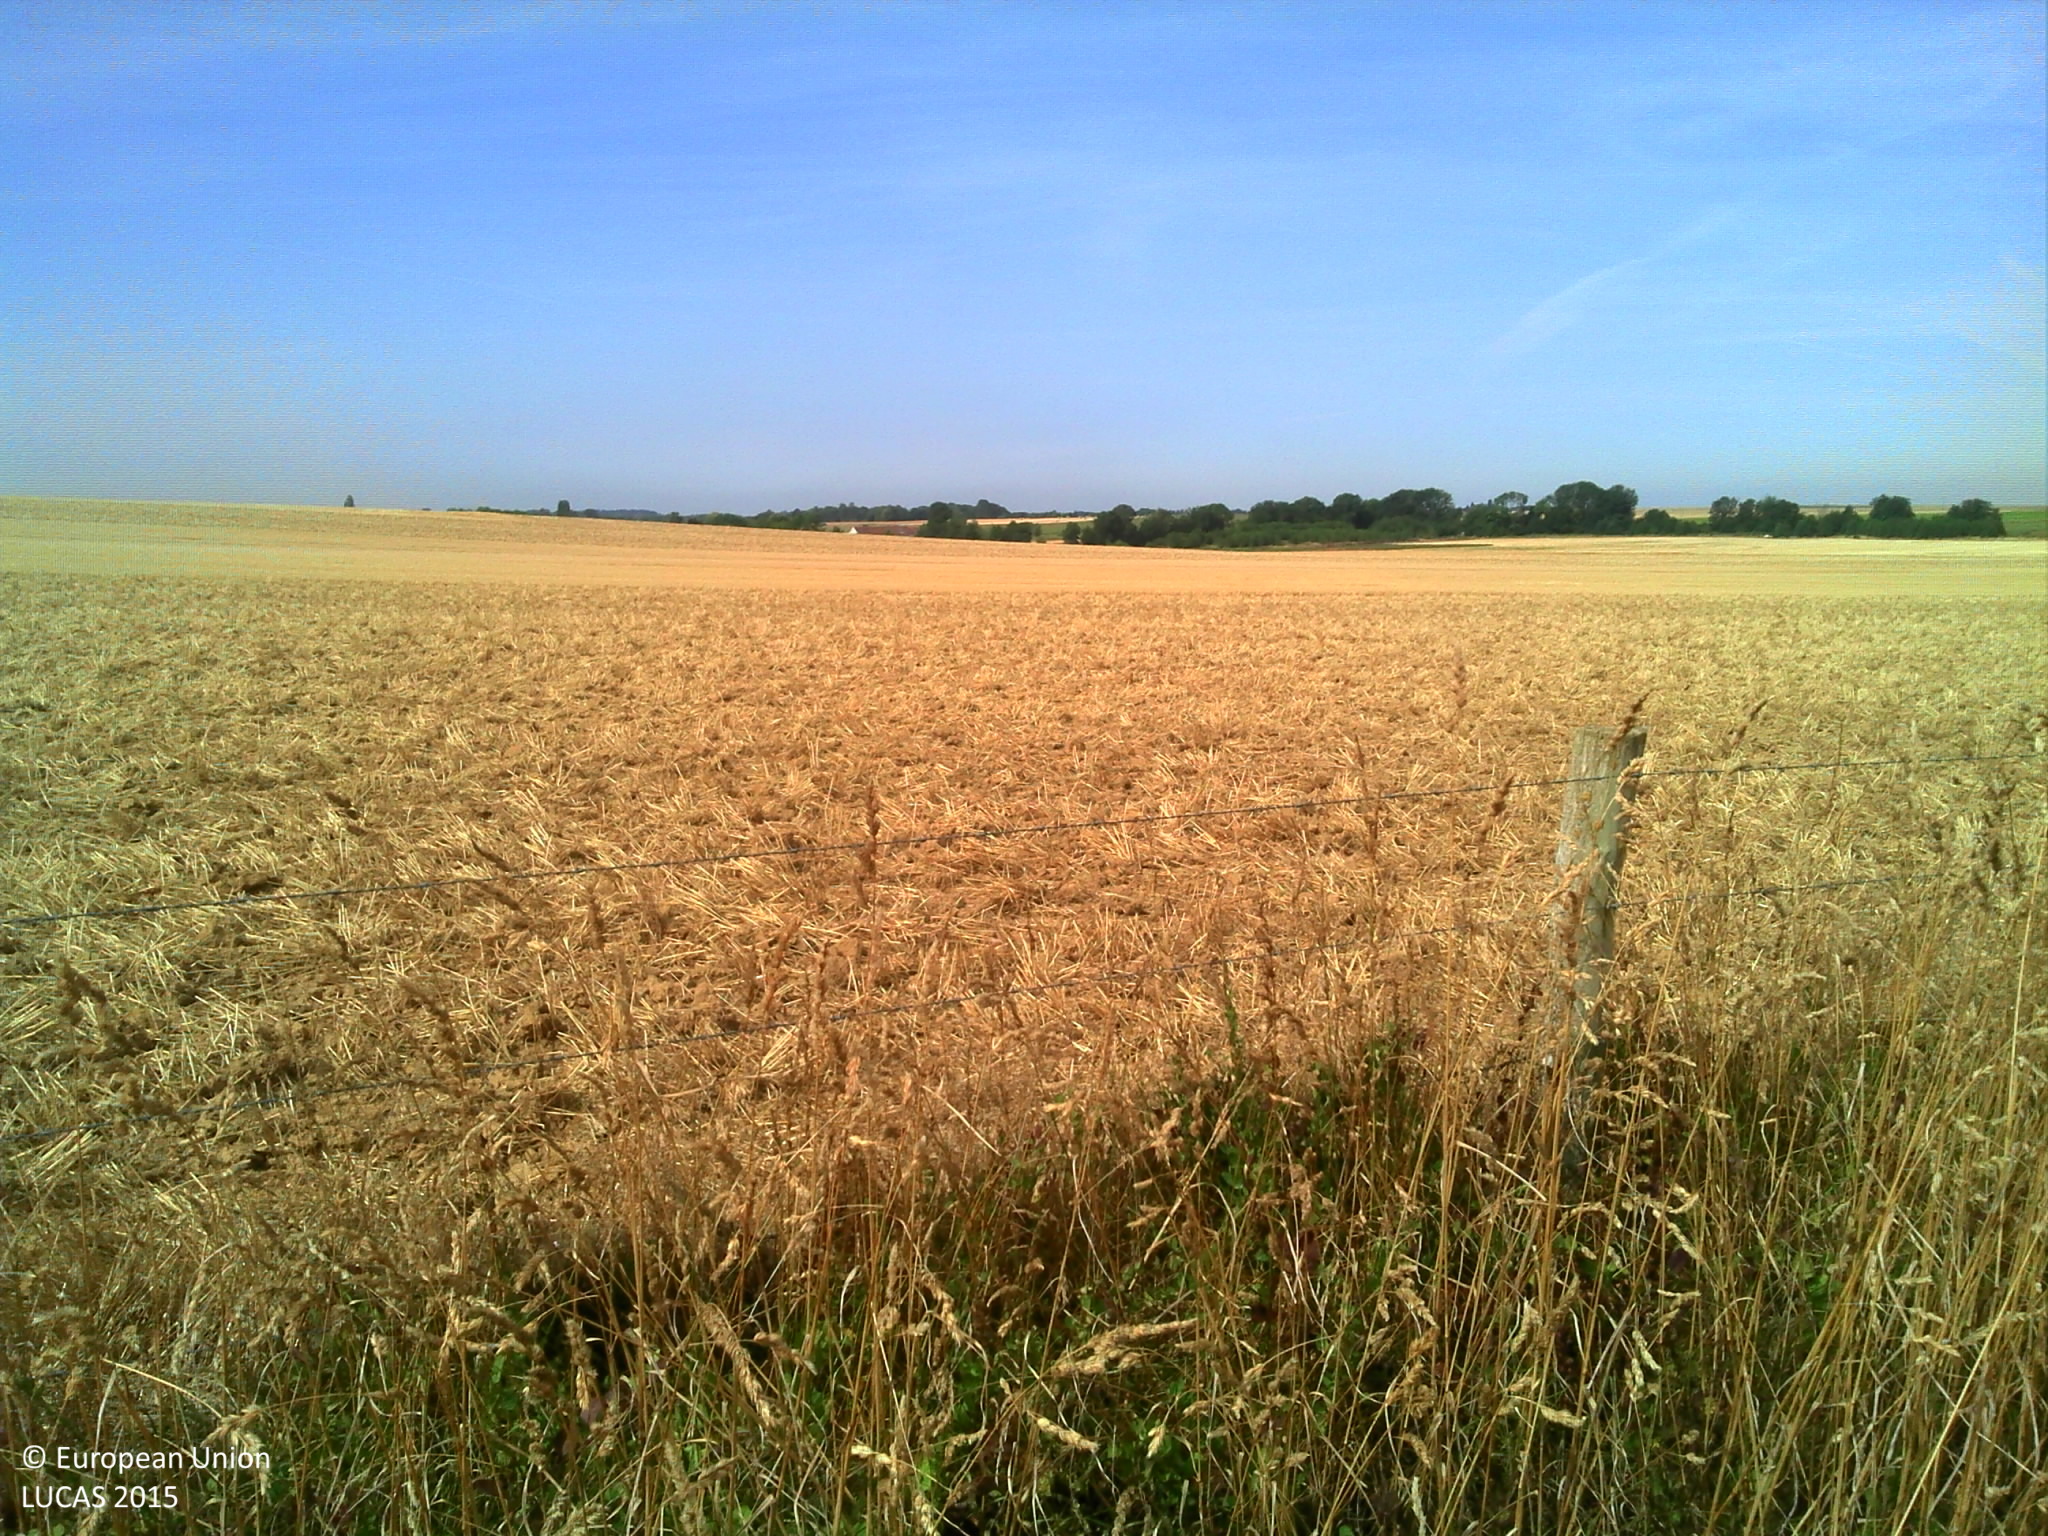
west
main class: Cropland
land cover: Common wheat
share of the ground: > 75 %
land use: Agriculture (excluding fallow land and kitchen gardens)
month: August
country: FR
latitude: 48.9055
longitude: 3.3212
